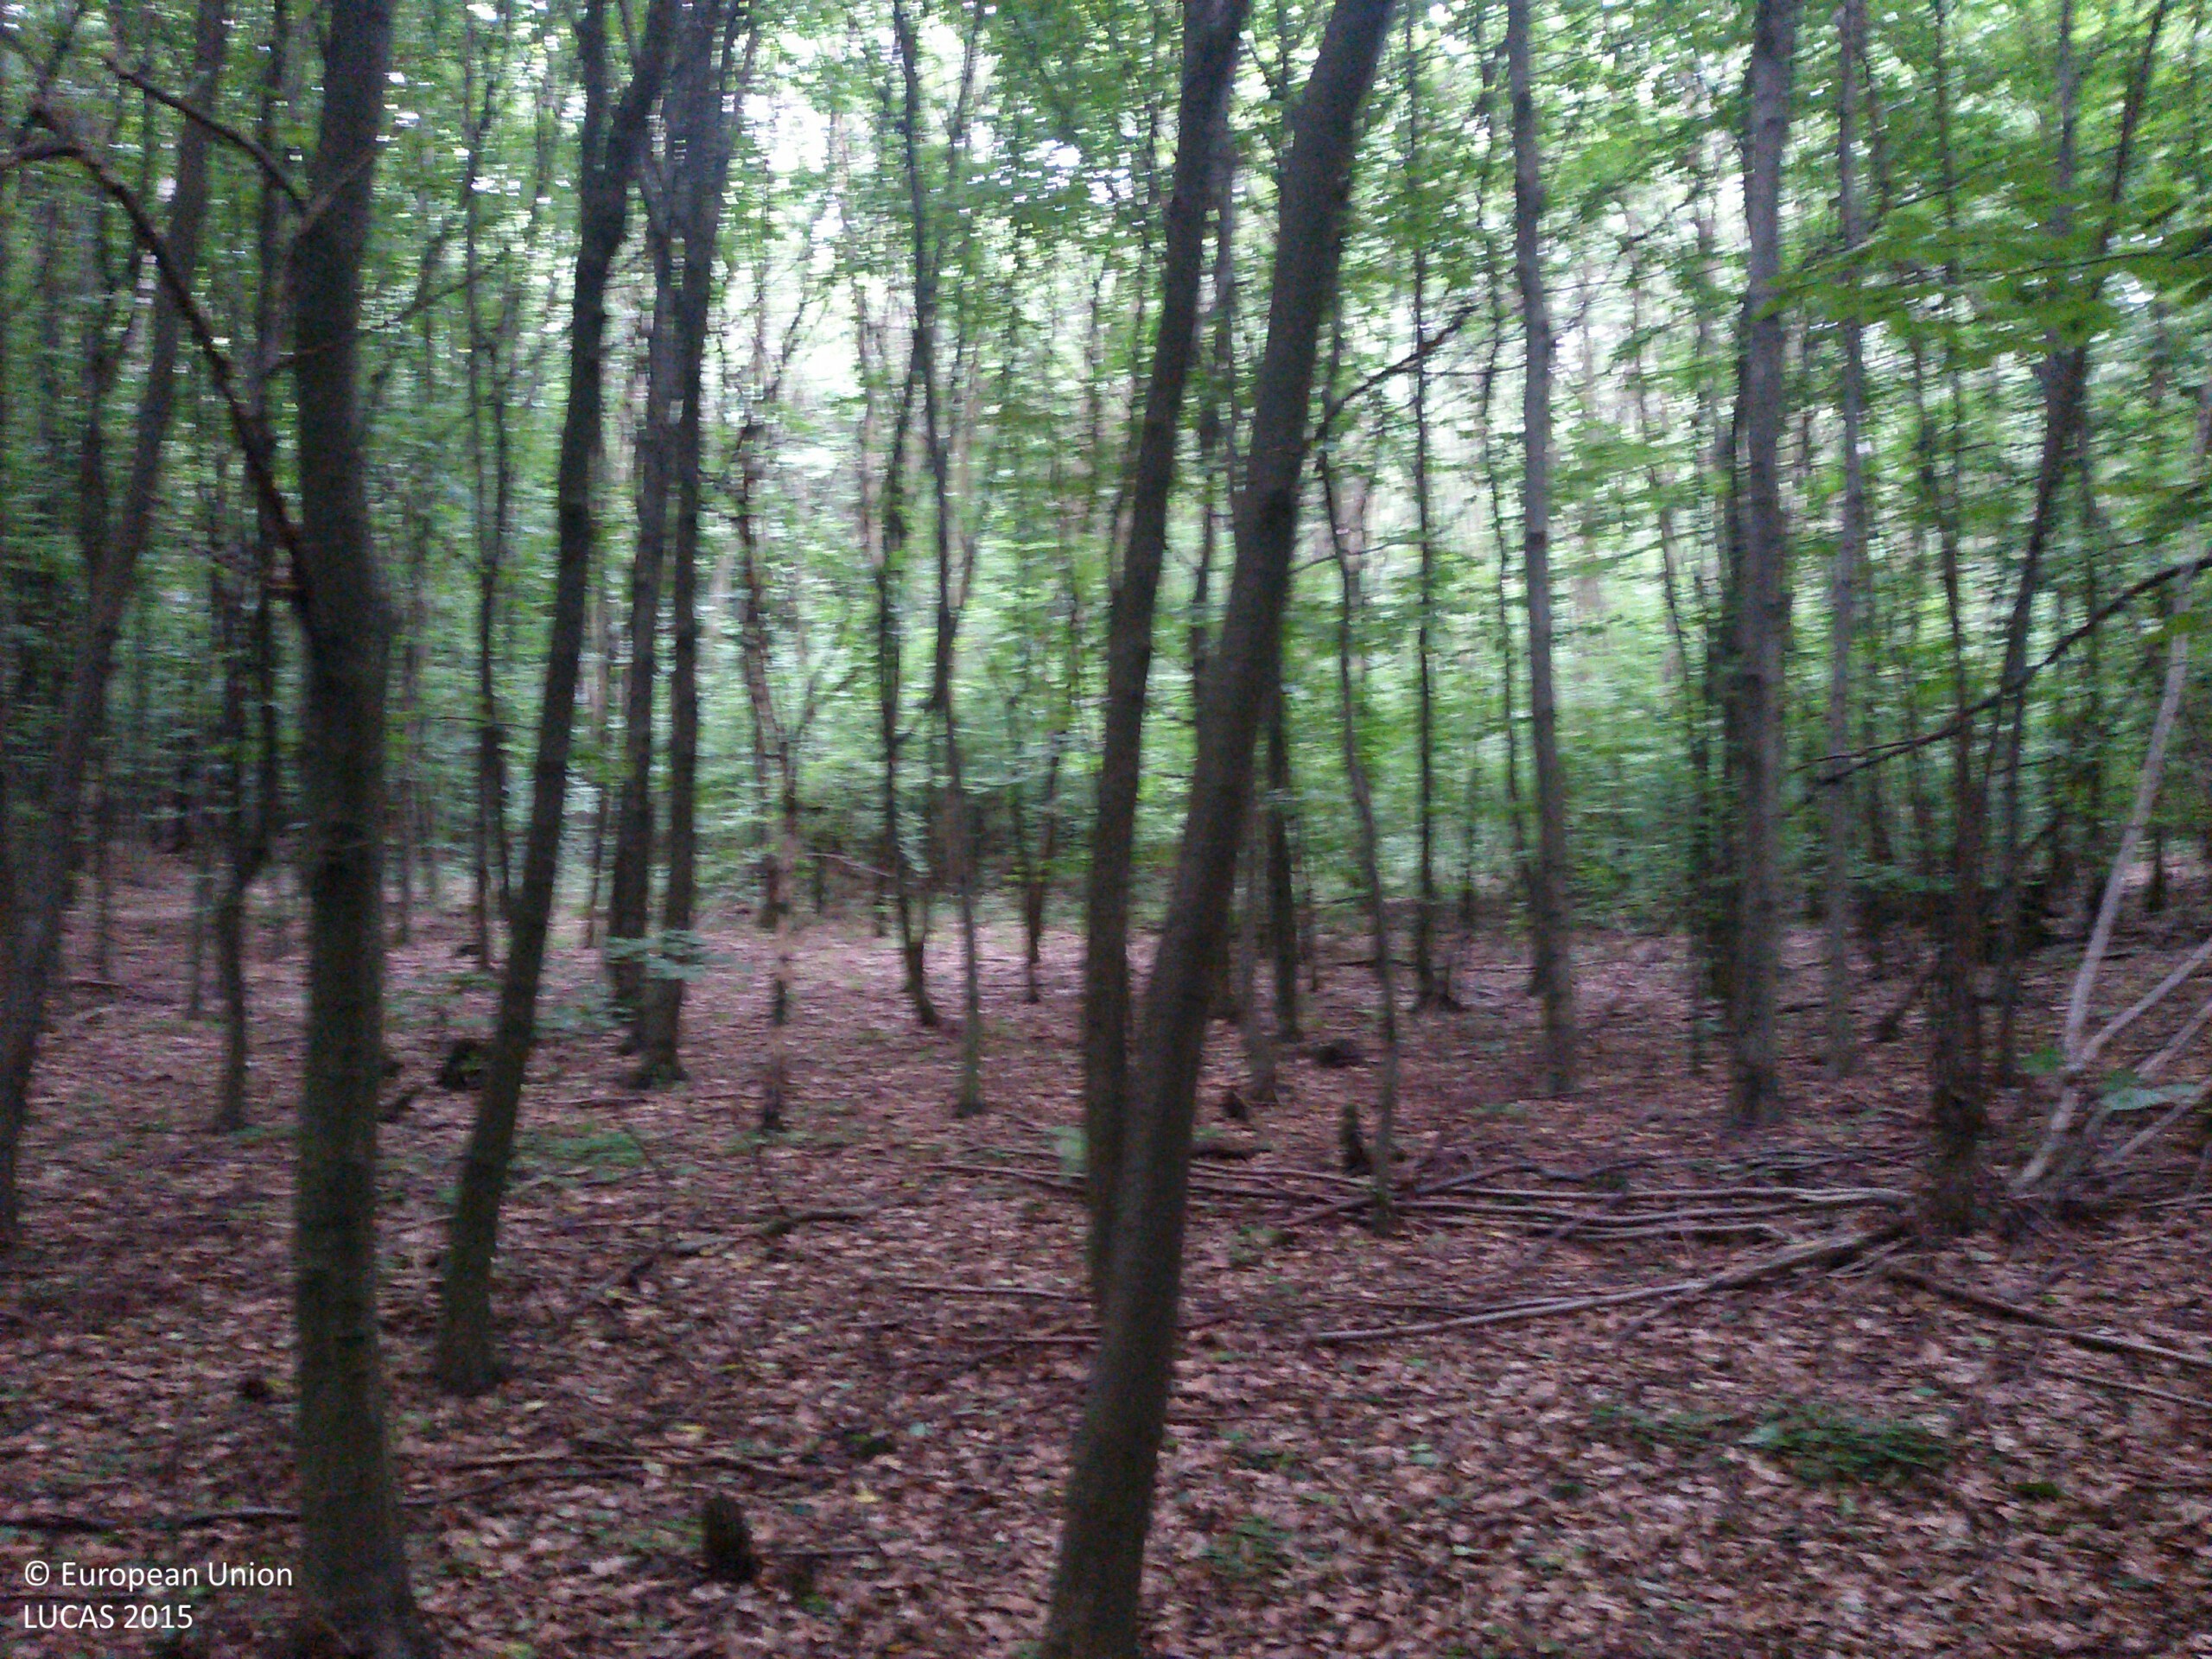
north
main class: Woodland
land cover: Broadleaved woodland
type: mesophytic deciduous forest
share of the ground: > 75 %
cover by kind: broadleaved forest trees 100 %
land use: Forestry
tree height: > 5 m
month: July
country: PL
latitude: 50.4315
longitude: 20.4124
